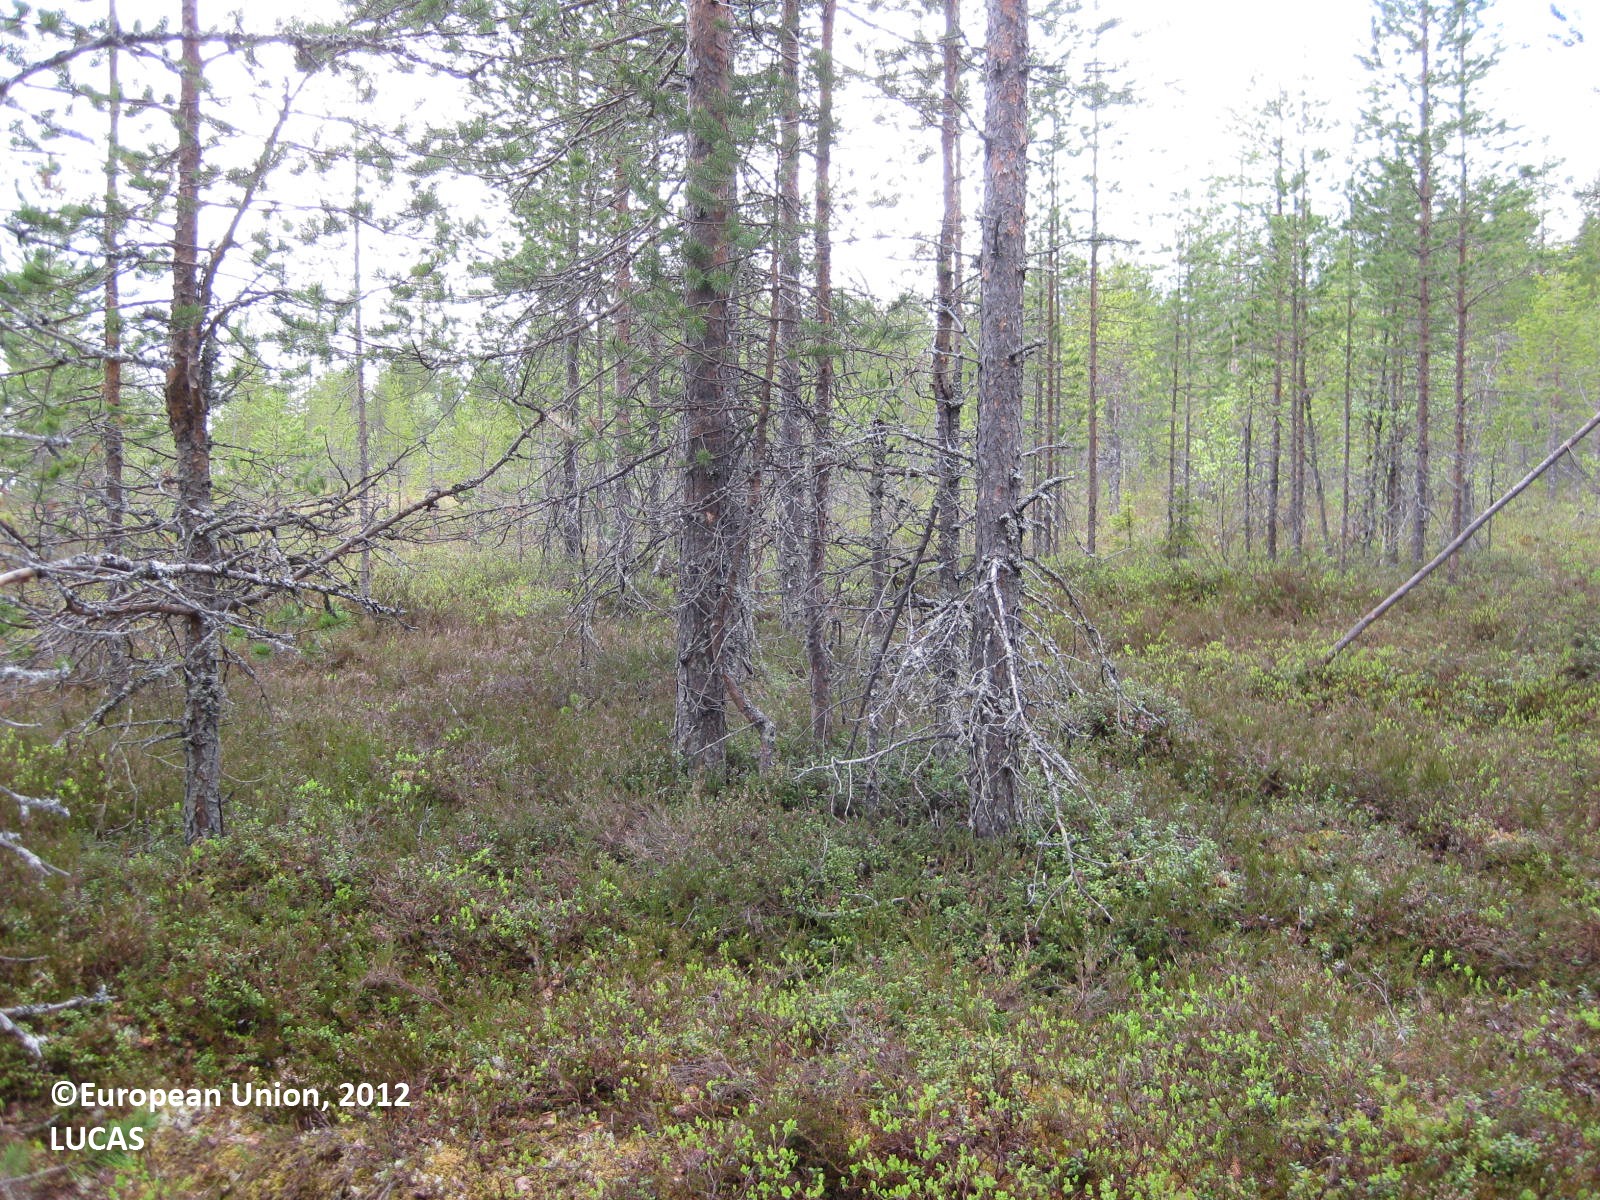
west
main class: Woodland
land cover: Pine dominated mixed woodland
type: boreal forest
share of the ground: 50 - 75 %
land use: Forestry
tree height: > 5 m
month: June
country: FI
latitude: 65.1745
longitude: 29.6557
